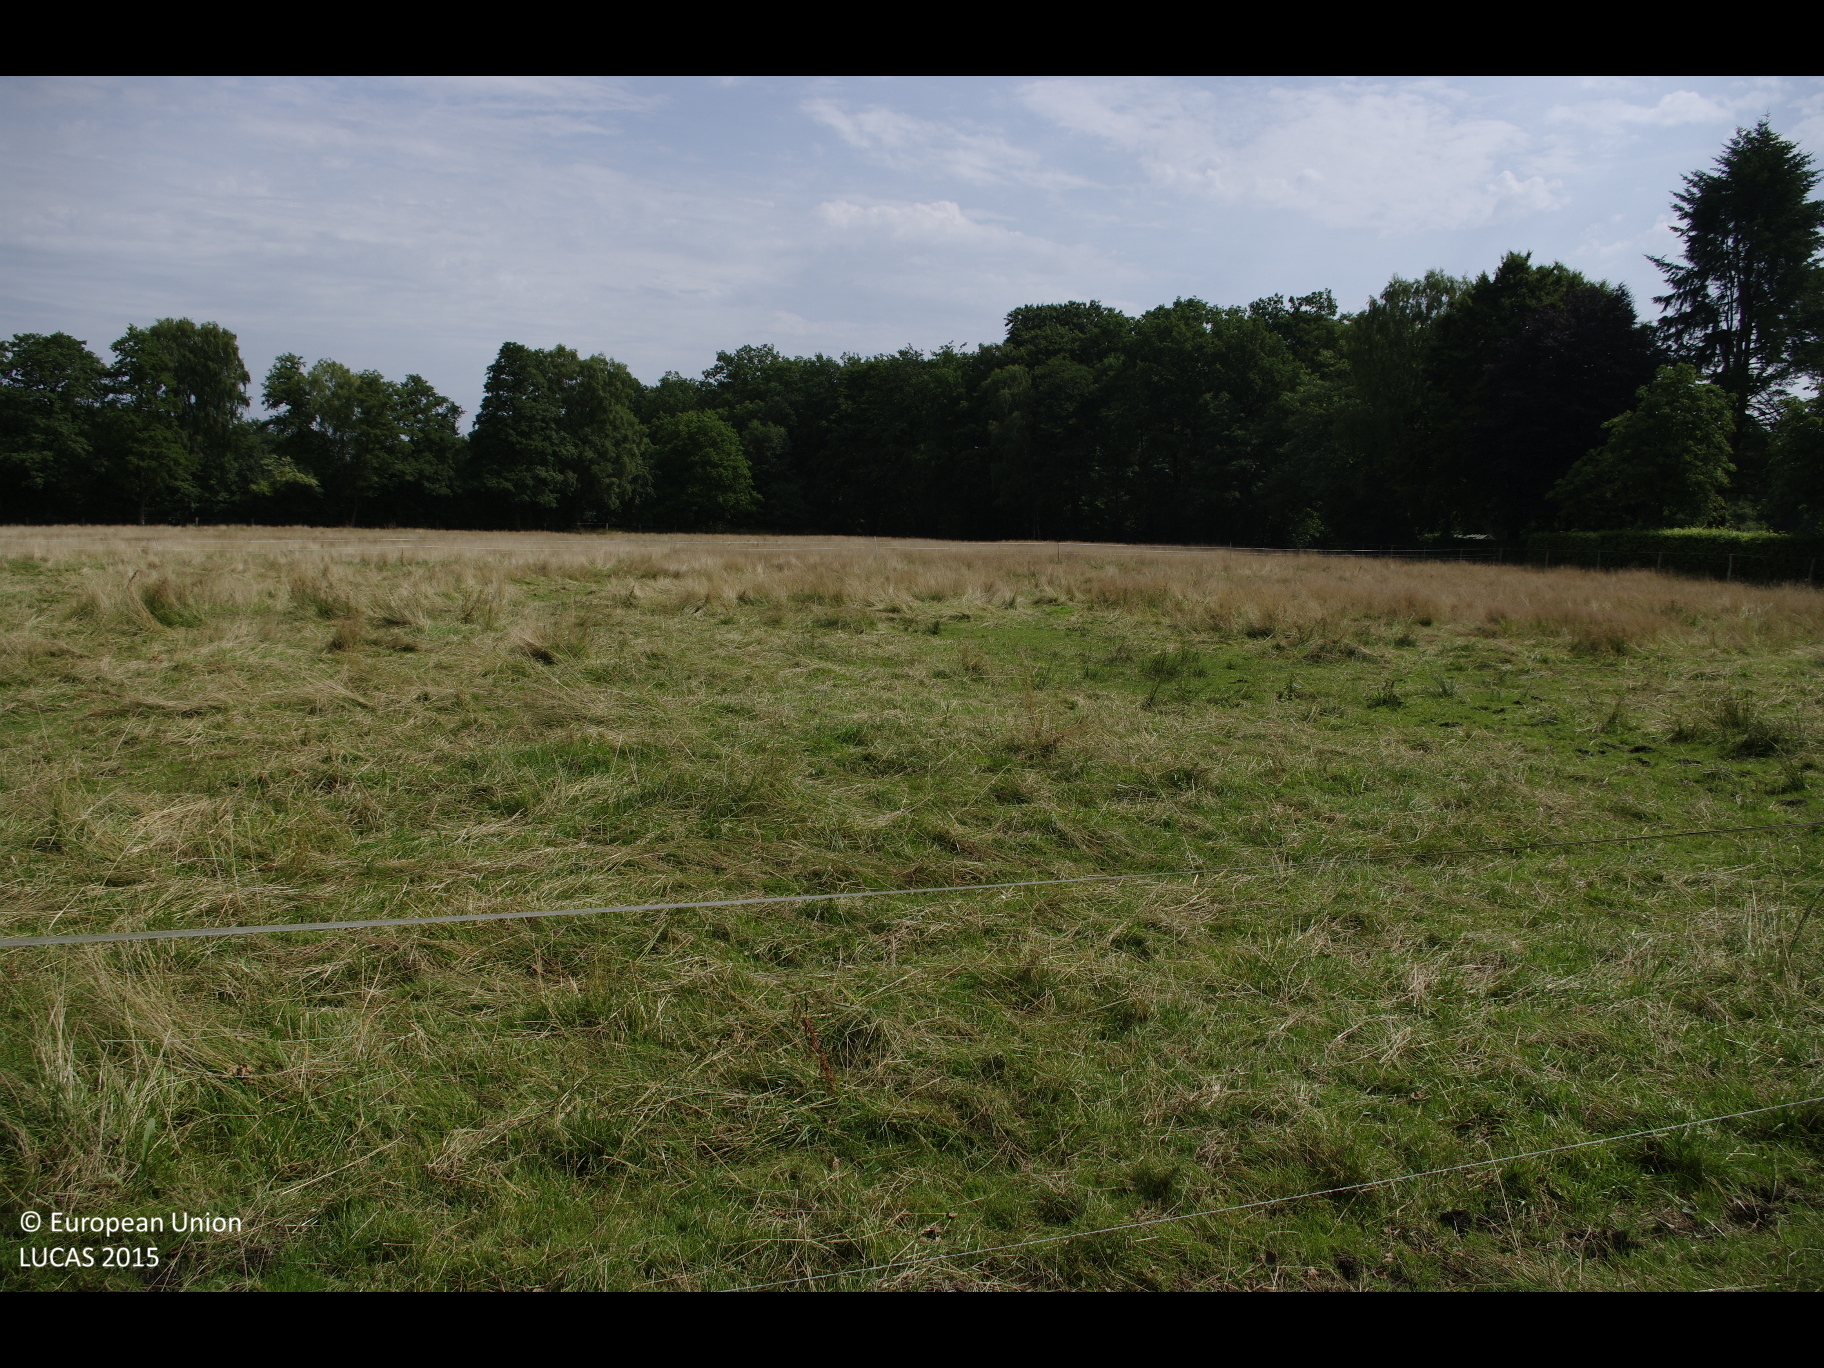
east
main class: Grassland
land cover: Grassland without tree/shrub cover
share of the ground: > 75 %
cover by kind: herbaceous plants 100 %
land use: Agriculture (excluding fallow land and kitchen gardens)
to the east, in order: Grassland without tree/shrub cover; Fences; Grassland without tree/shrub cover; Fences; Broadleaved woodland
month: August
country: DE
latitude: 53.2581
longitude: 9.8652
